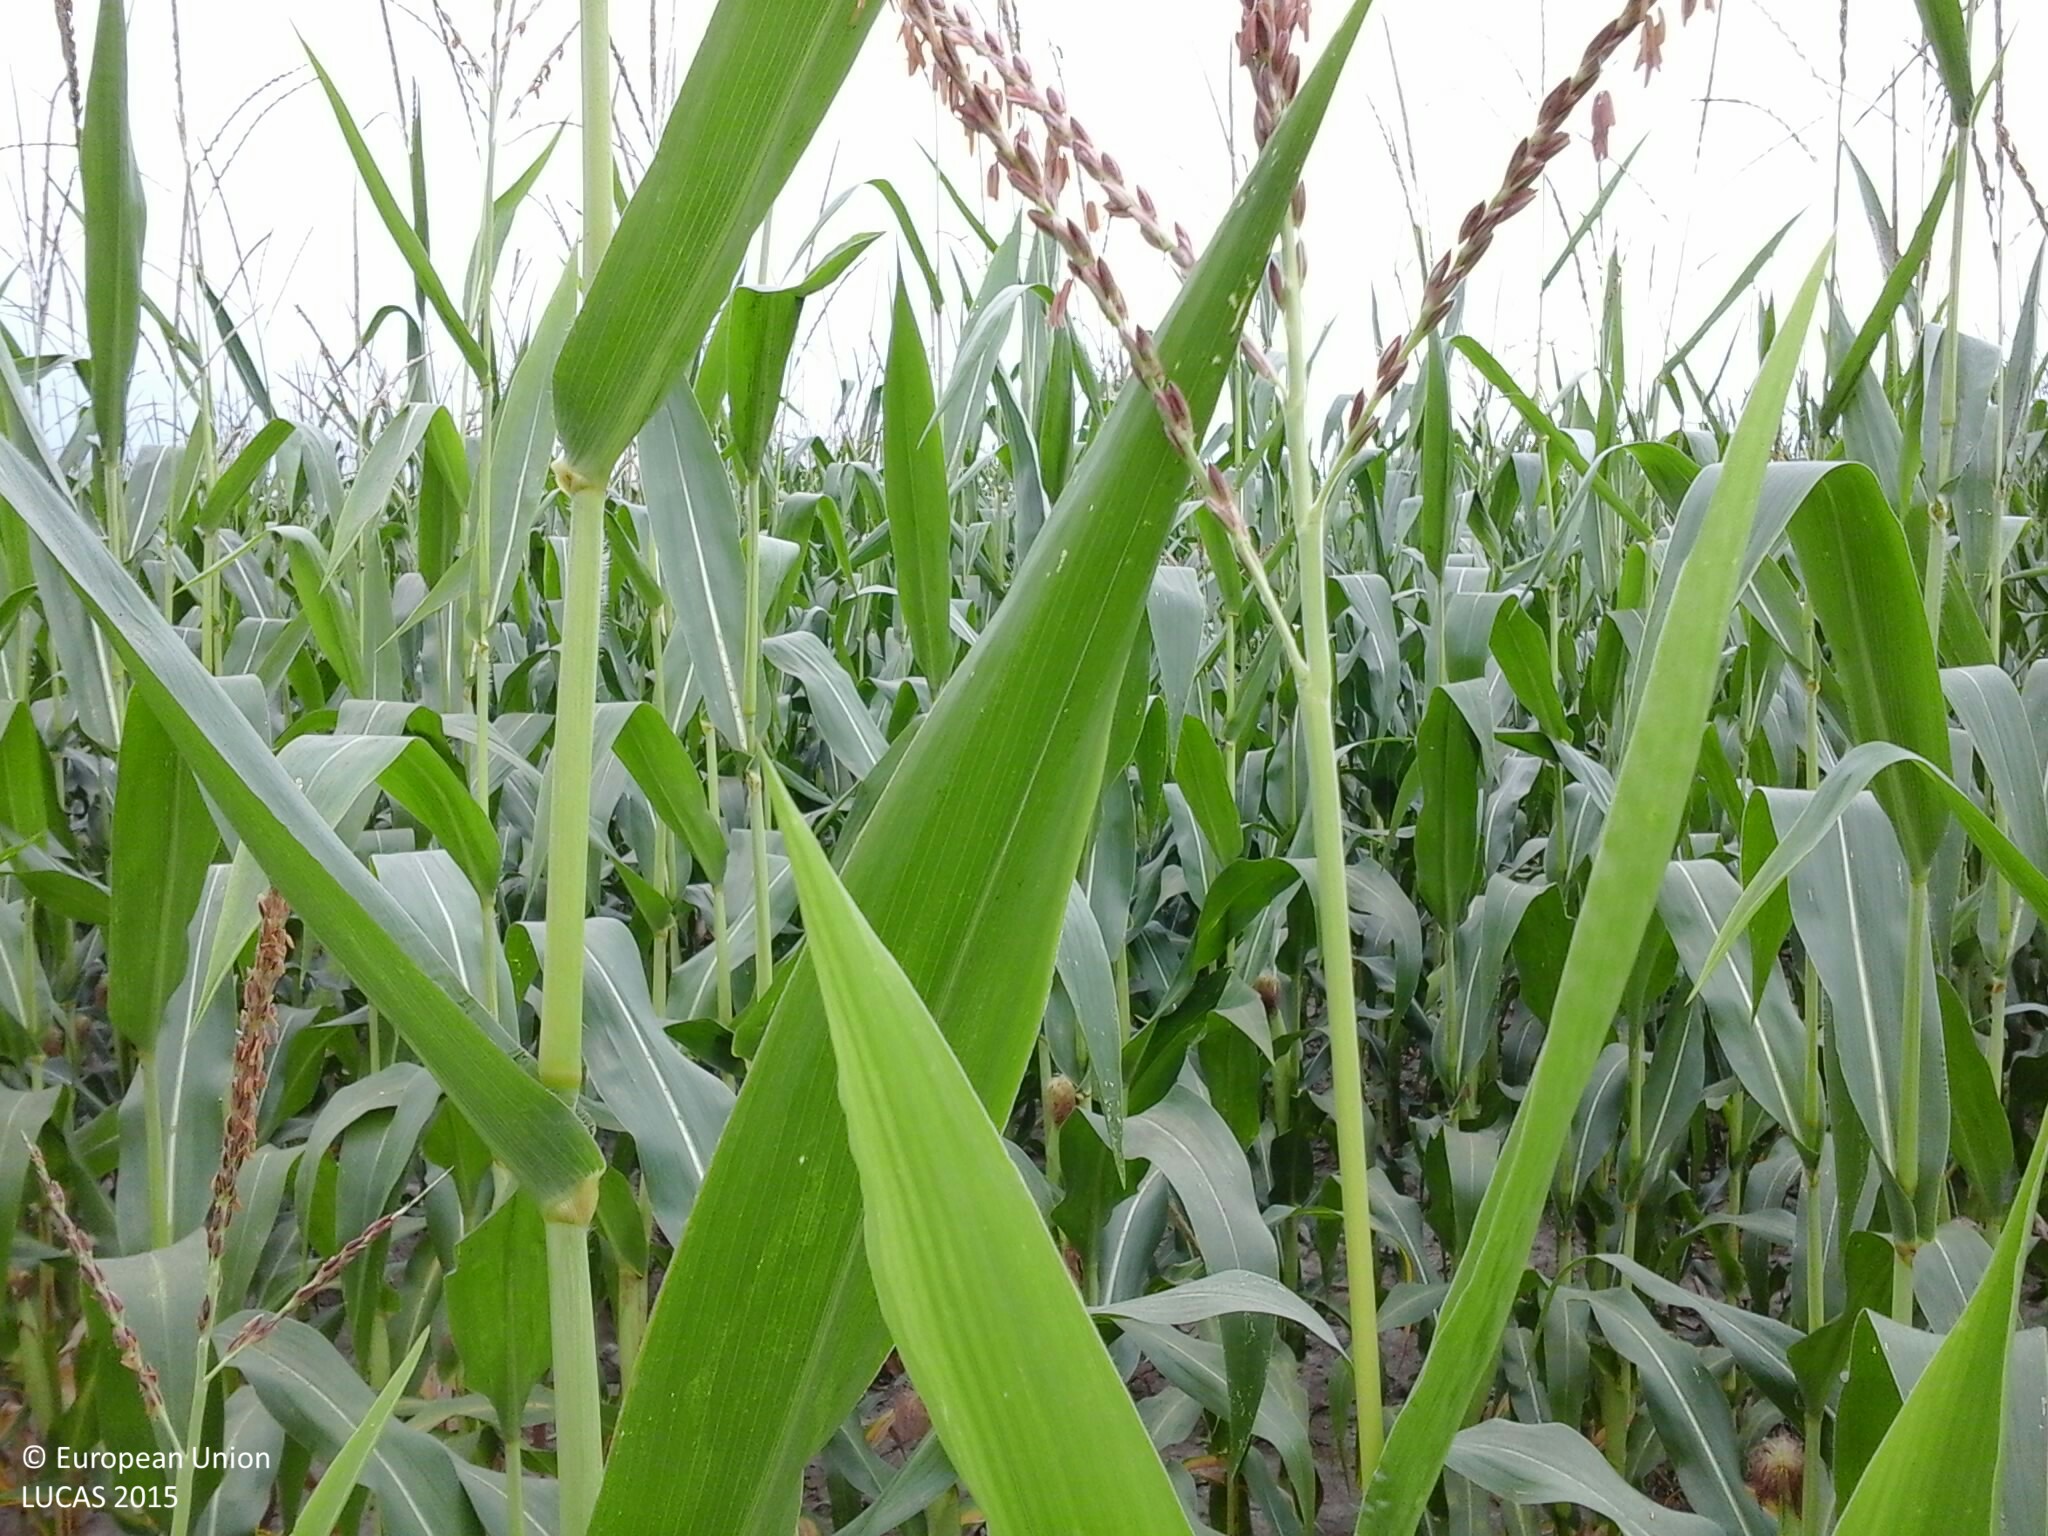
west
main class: Cropland
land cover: Maize
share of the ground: > 75 %
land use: Agriculture (excluding fallow land and kitchen gardens)
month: July
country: HU
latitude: 46.6463
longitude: 16.4164
